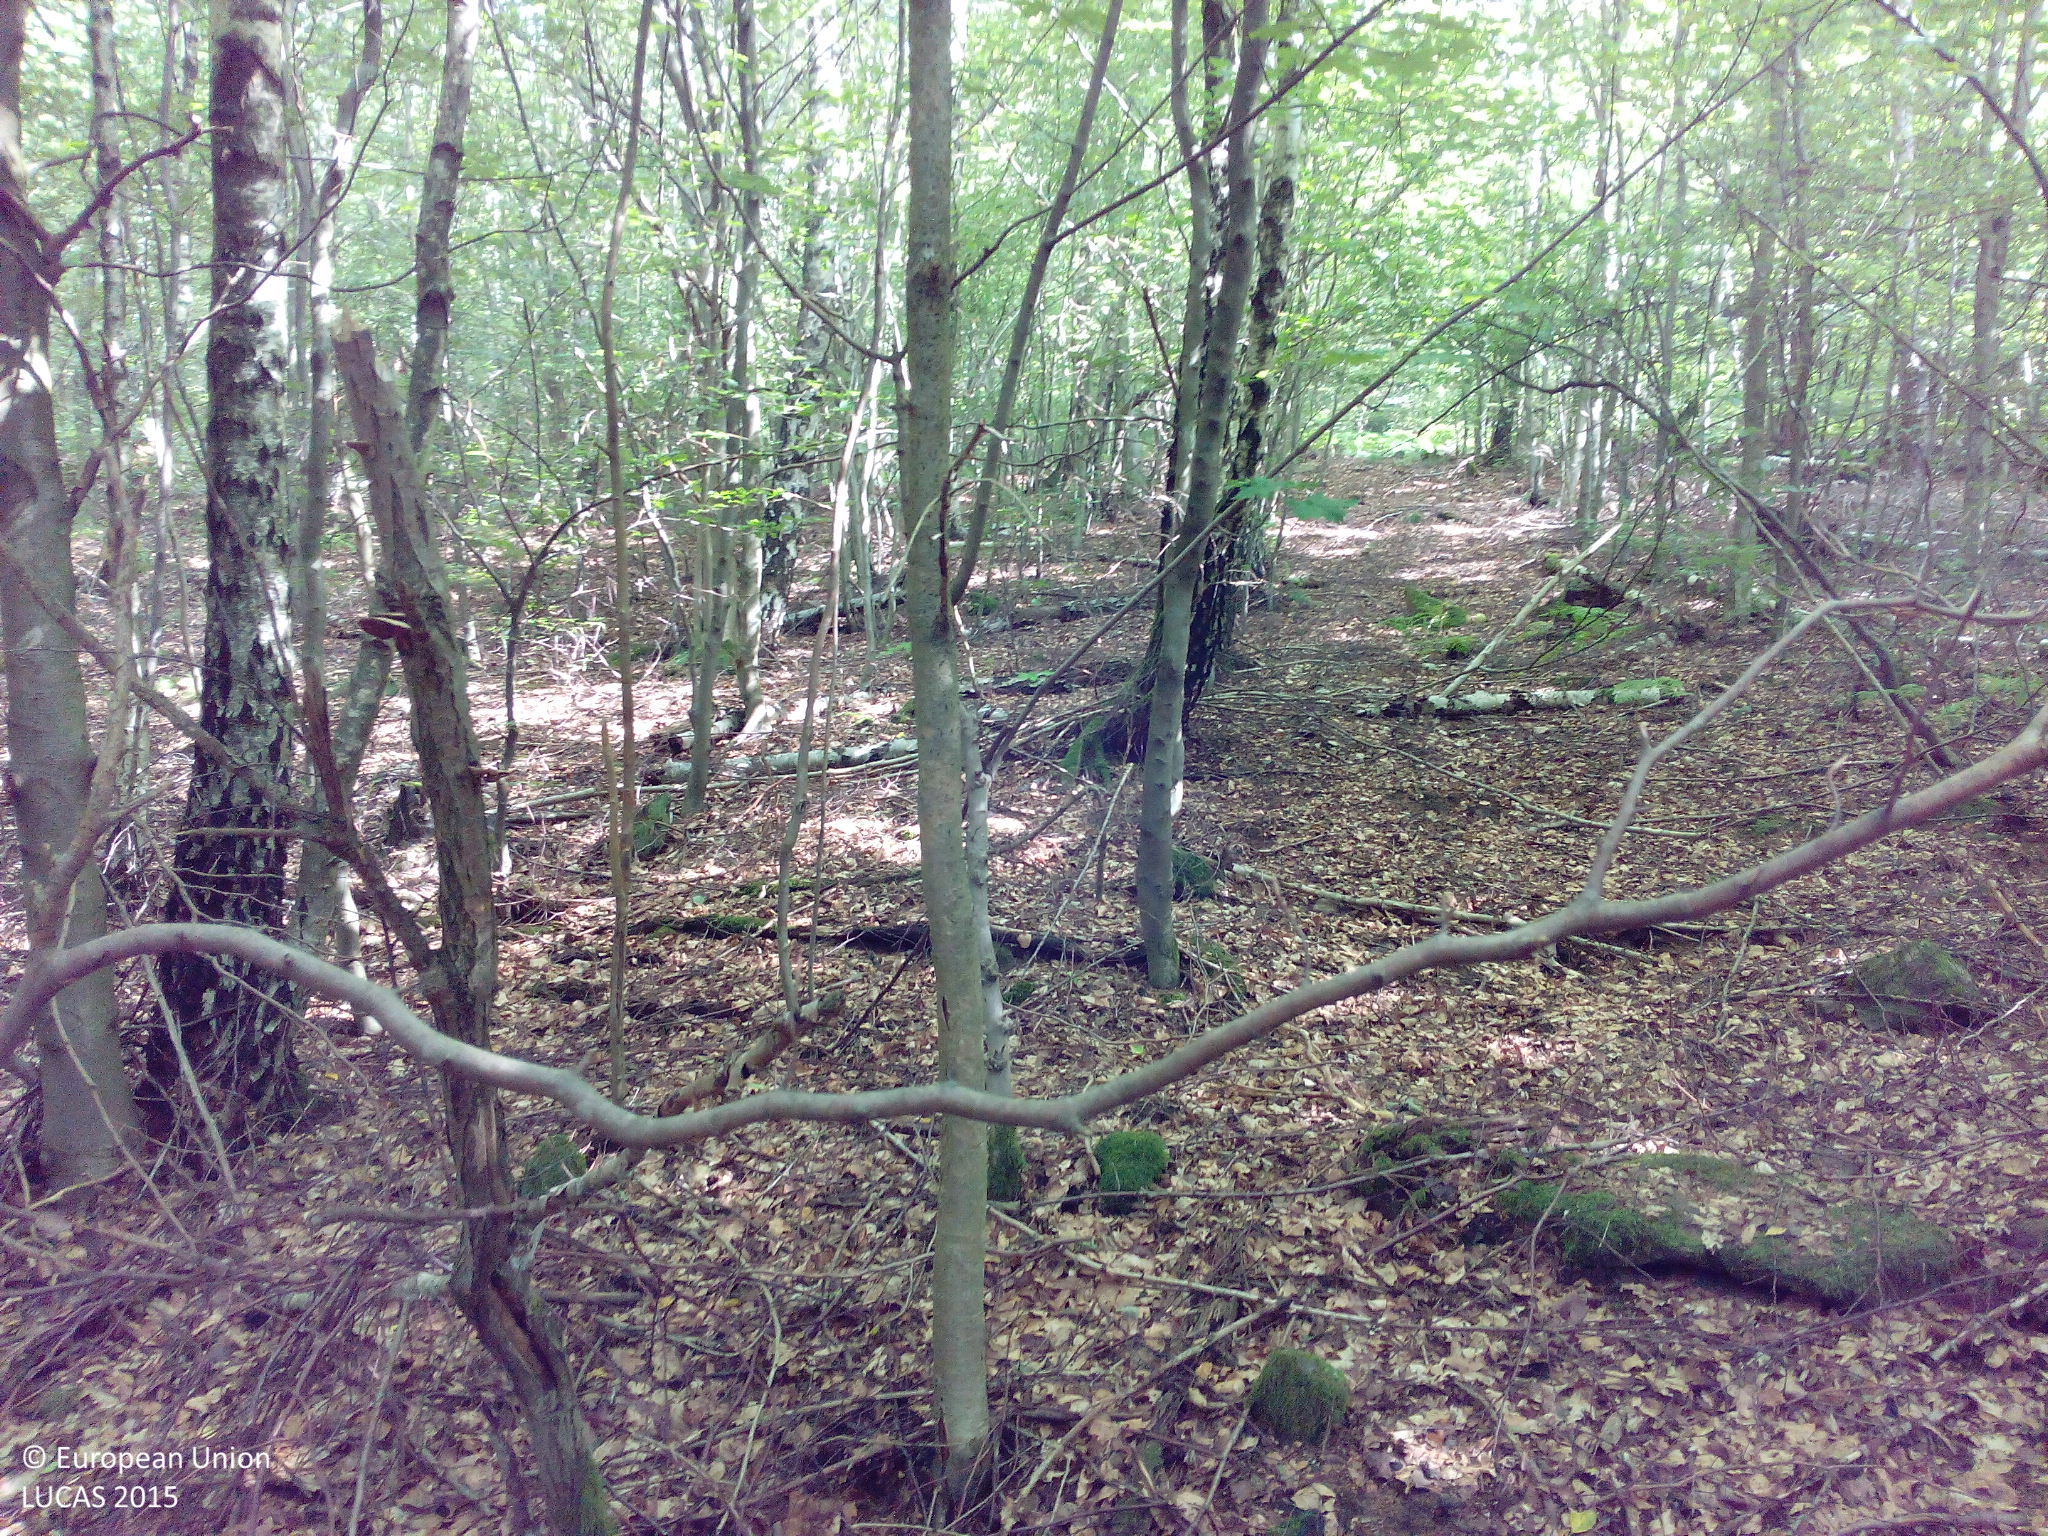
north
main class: Woodland
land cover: Broadleaved woodland
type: beech forest
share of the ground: > 75 %
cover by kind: broadleaved forest trees 100 %
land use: Forestry
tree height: > 5 m
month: July
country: DE
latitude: 50.5798
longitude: 9.9012
